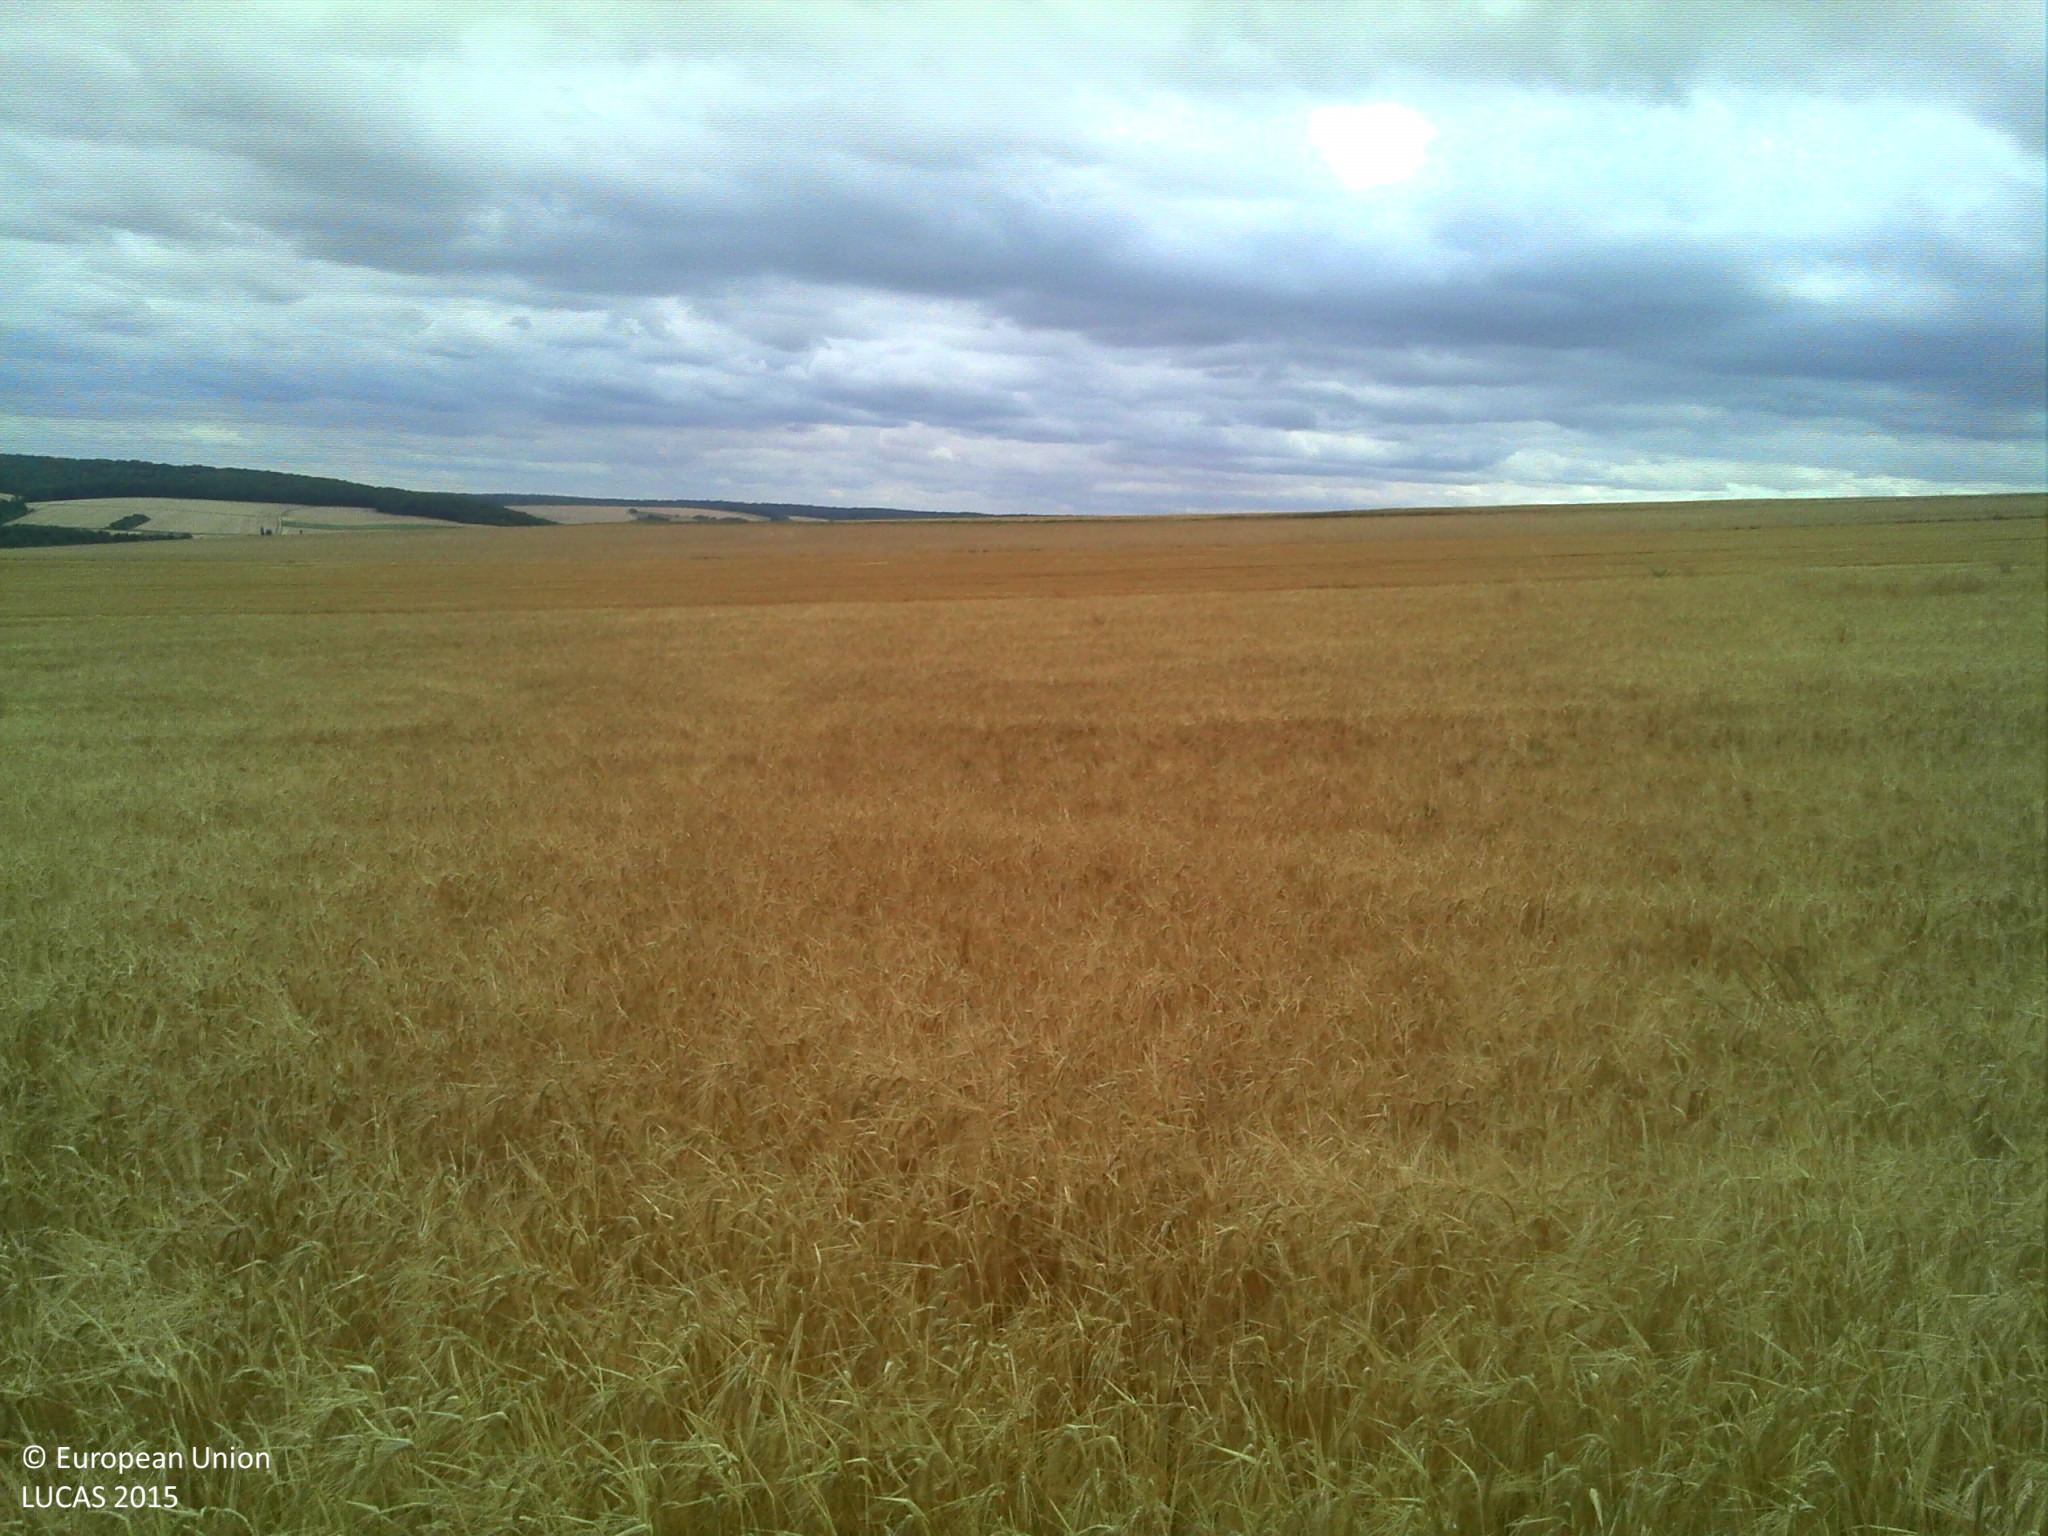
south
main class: Cropland
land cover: Barley
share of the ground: > 75 %
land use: Agriculture (excluding fallow land and kitchen gardens)
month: July
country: FR
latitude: 48.1892
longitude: 3.4163
